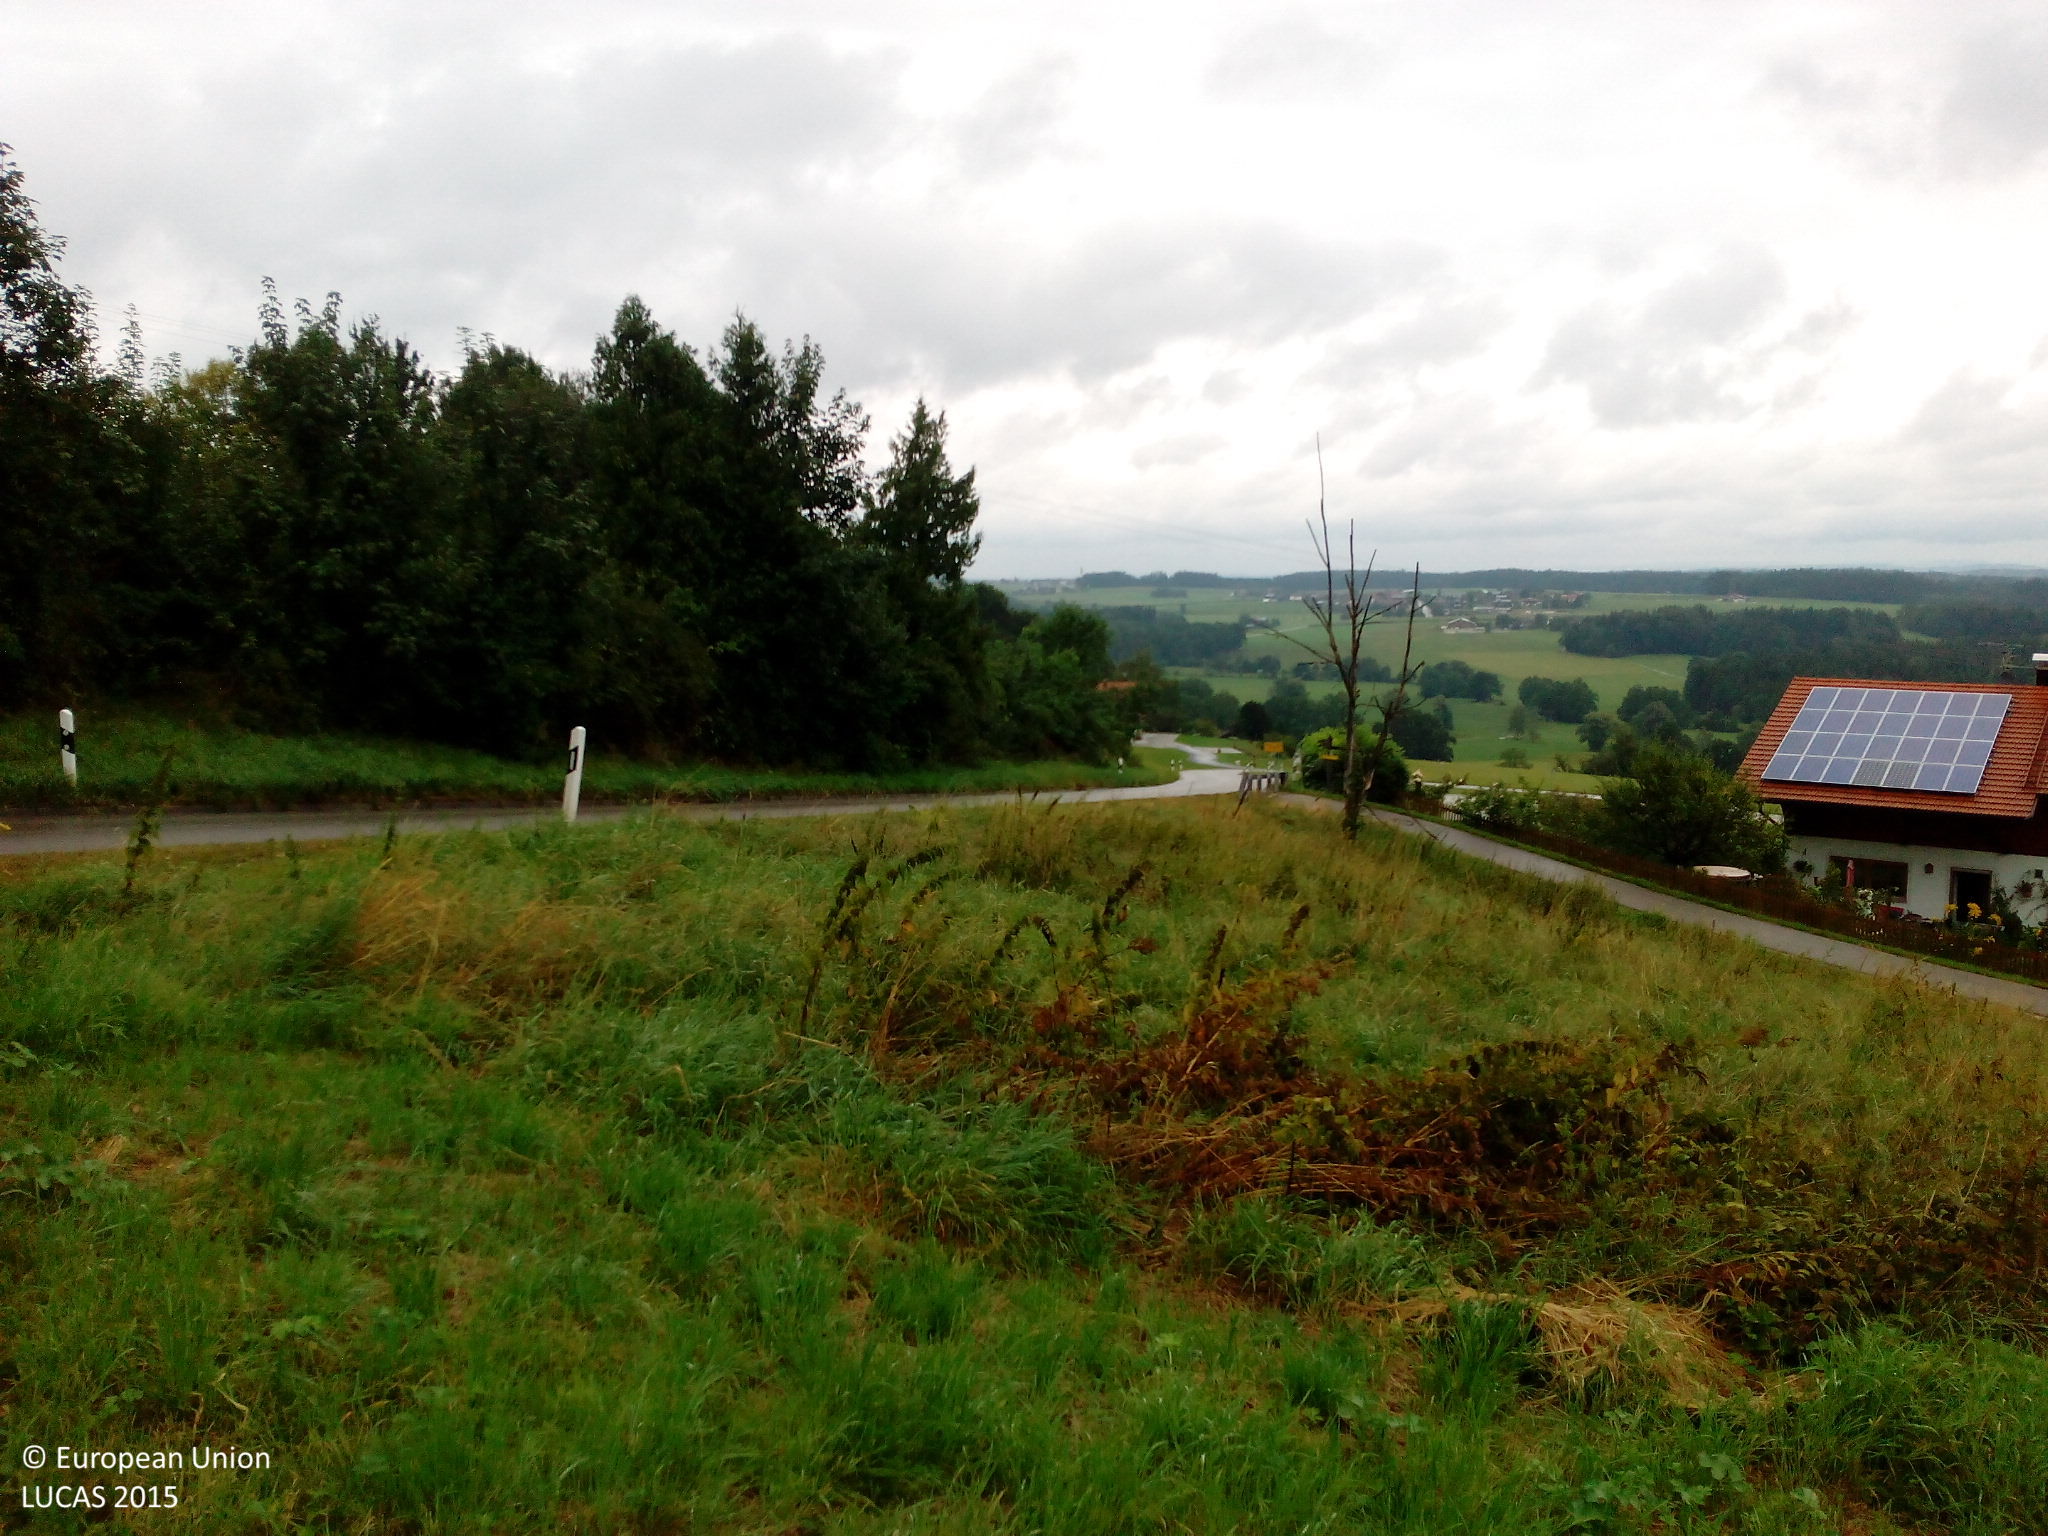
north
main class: Grassland
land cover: Grassland with sparse tree/shrub cover
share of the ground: > 75 %
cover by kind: herbaceous plants 95 %, broadleaved forest trees 5 %
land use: Residential
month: August
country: DE
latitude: 47.8260
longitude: 12.8706
